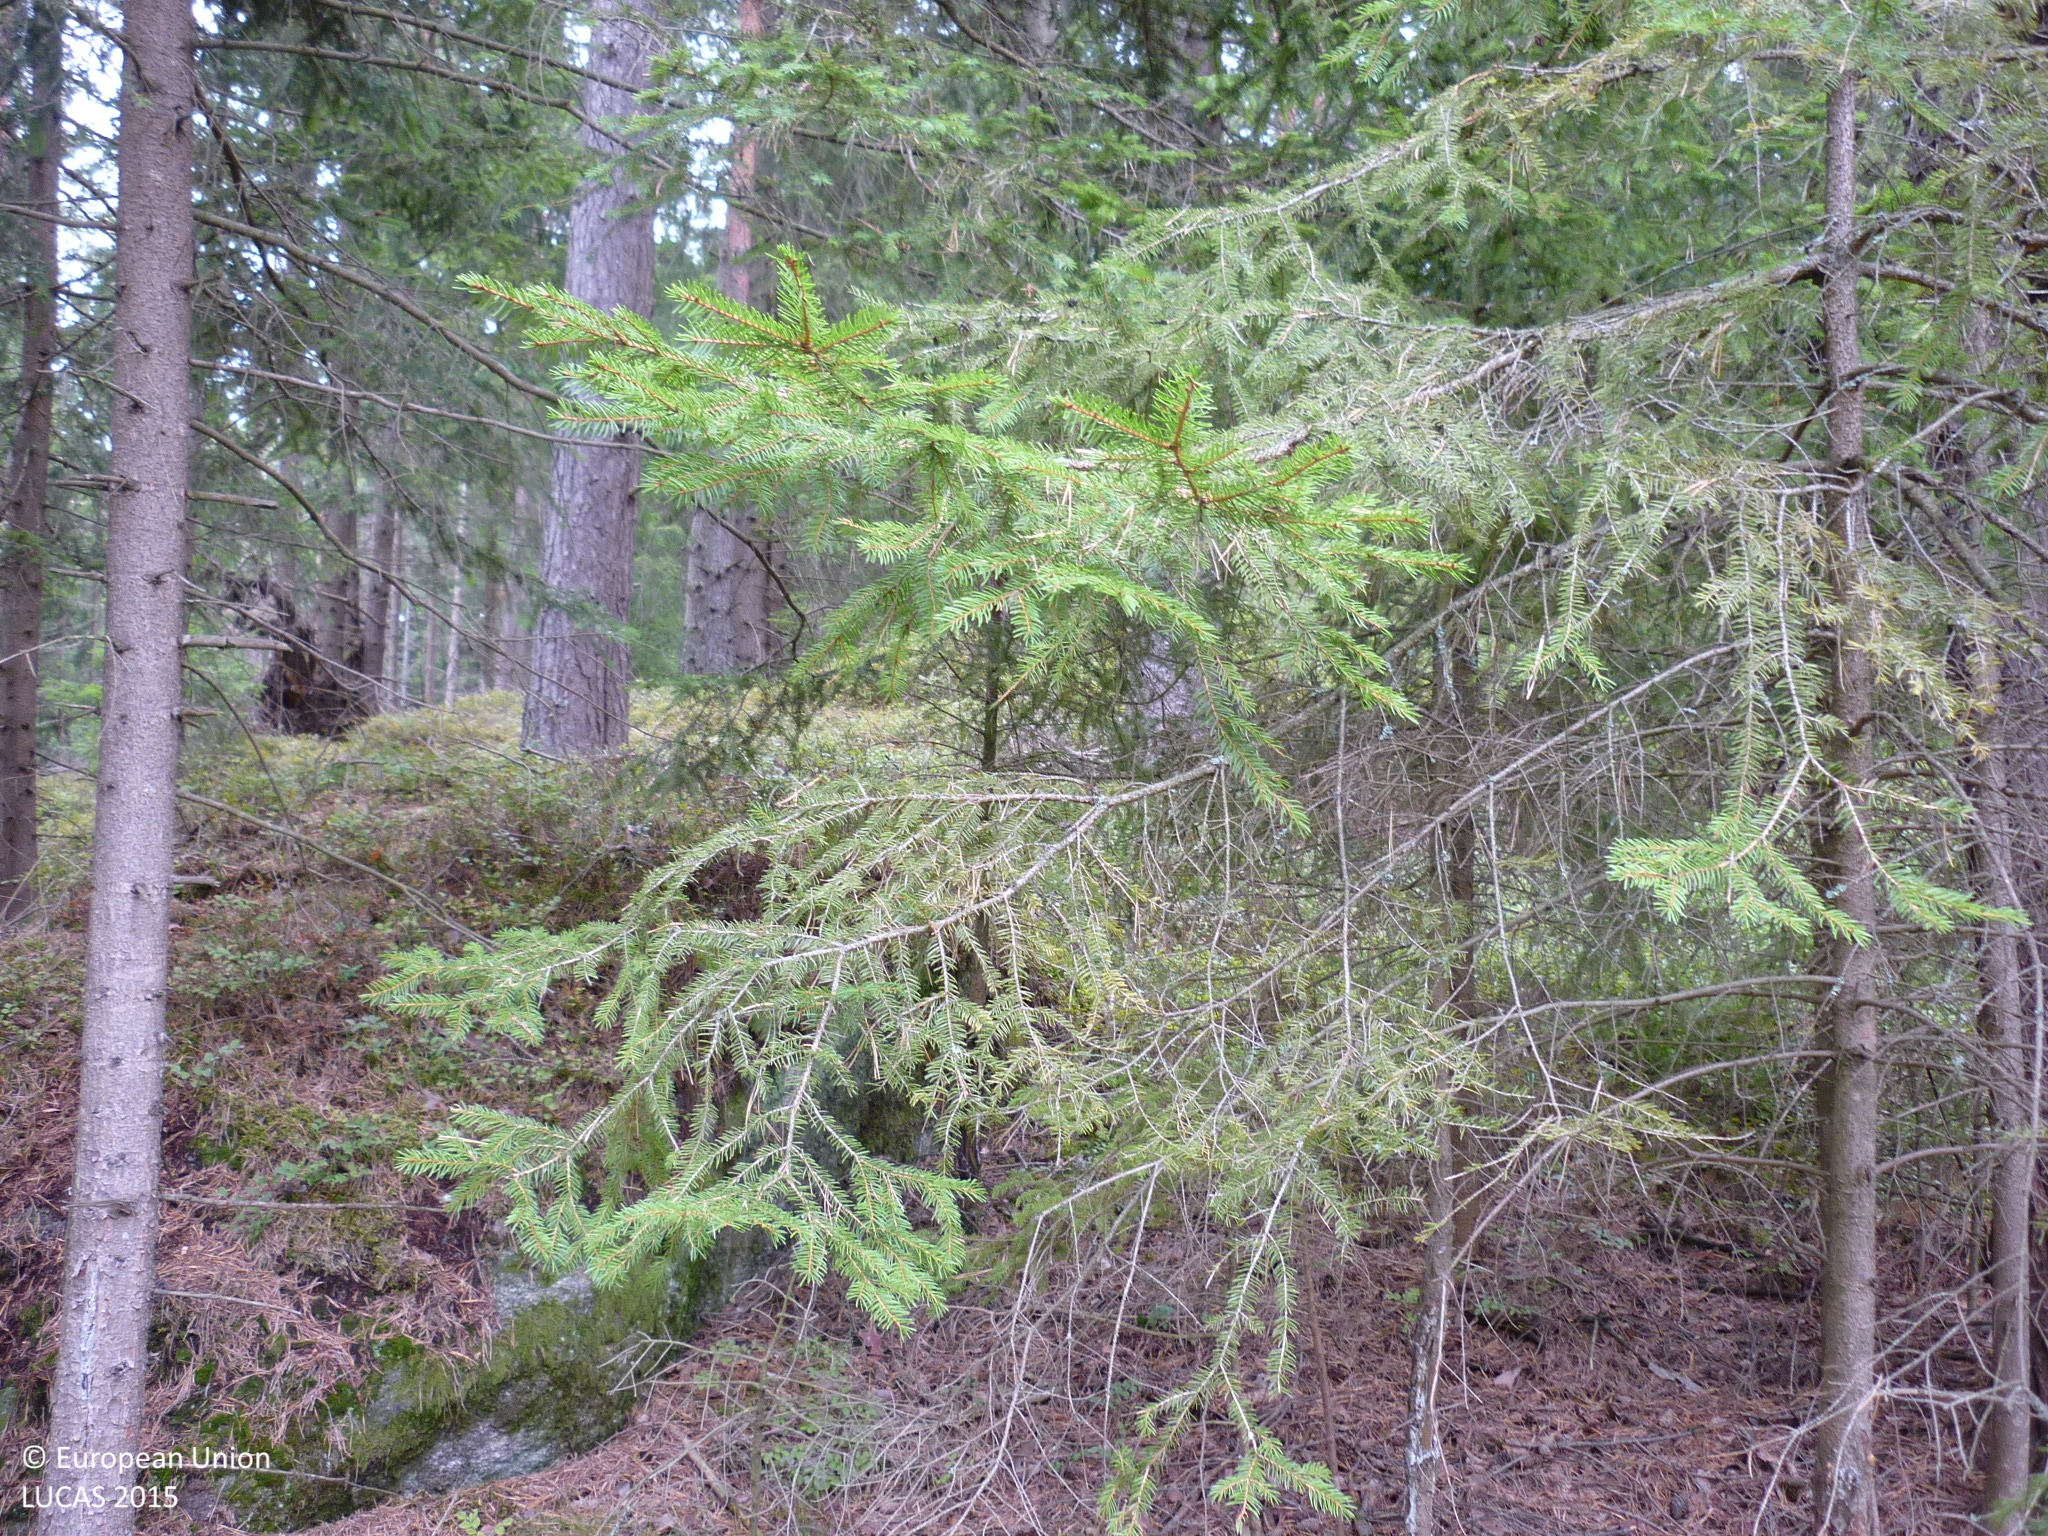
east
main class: Woodland
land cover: Spruce dominated coniferous woodland
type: hemiboreal forest and nemoral coniferous forest and mixed broadleaved-coniferous forest
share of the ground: > 75 %
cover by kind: coniferous forest trees 100 %
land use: Forestry
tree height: > 5 m
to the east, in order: Spruce dominated coniferous woodland; Pine dominated coniferous woodland; Spruce dominated coniferous woodland; Shruby margins; Tracks; Spruce dominated coniferous woodland
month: September
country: AT
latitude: 48.8479
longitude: 15.0305
